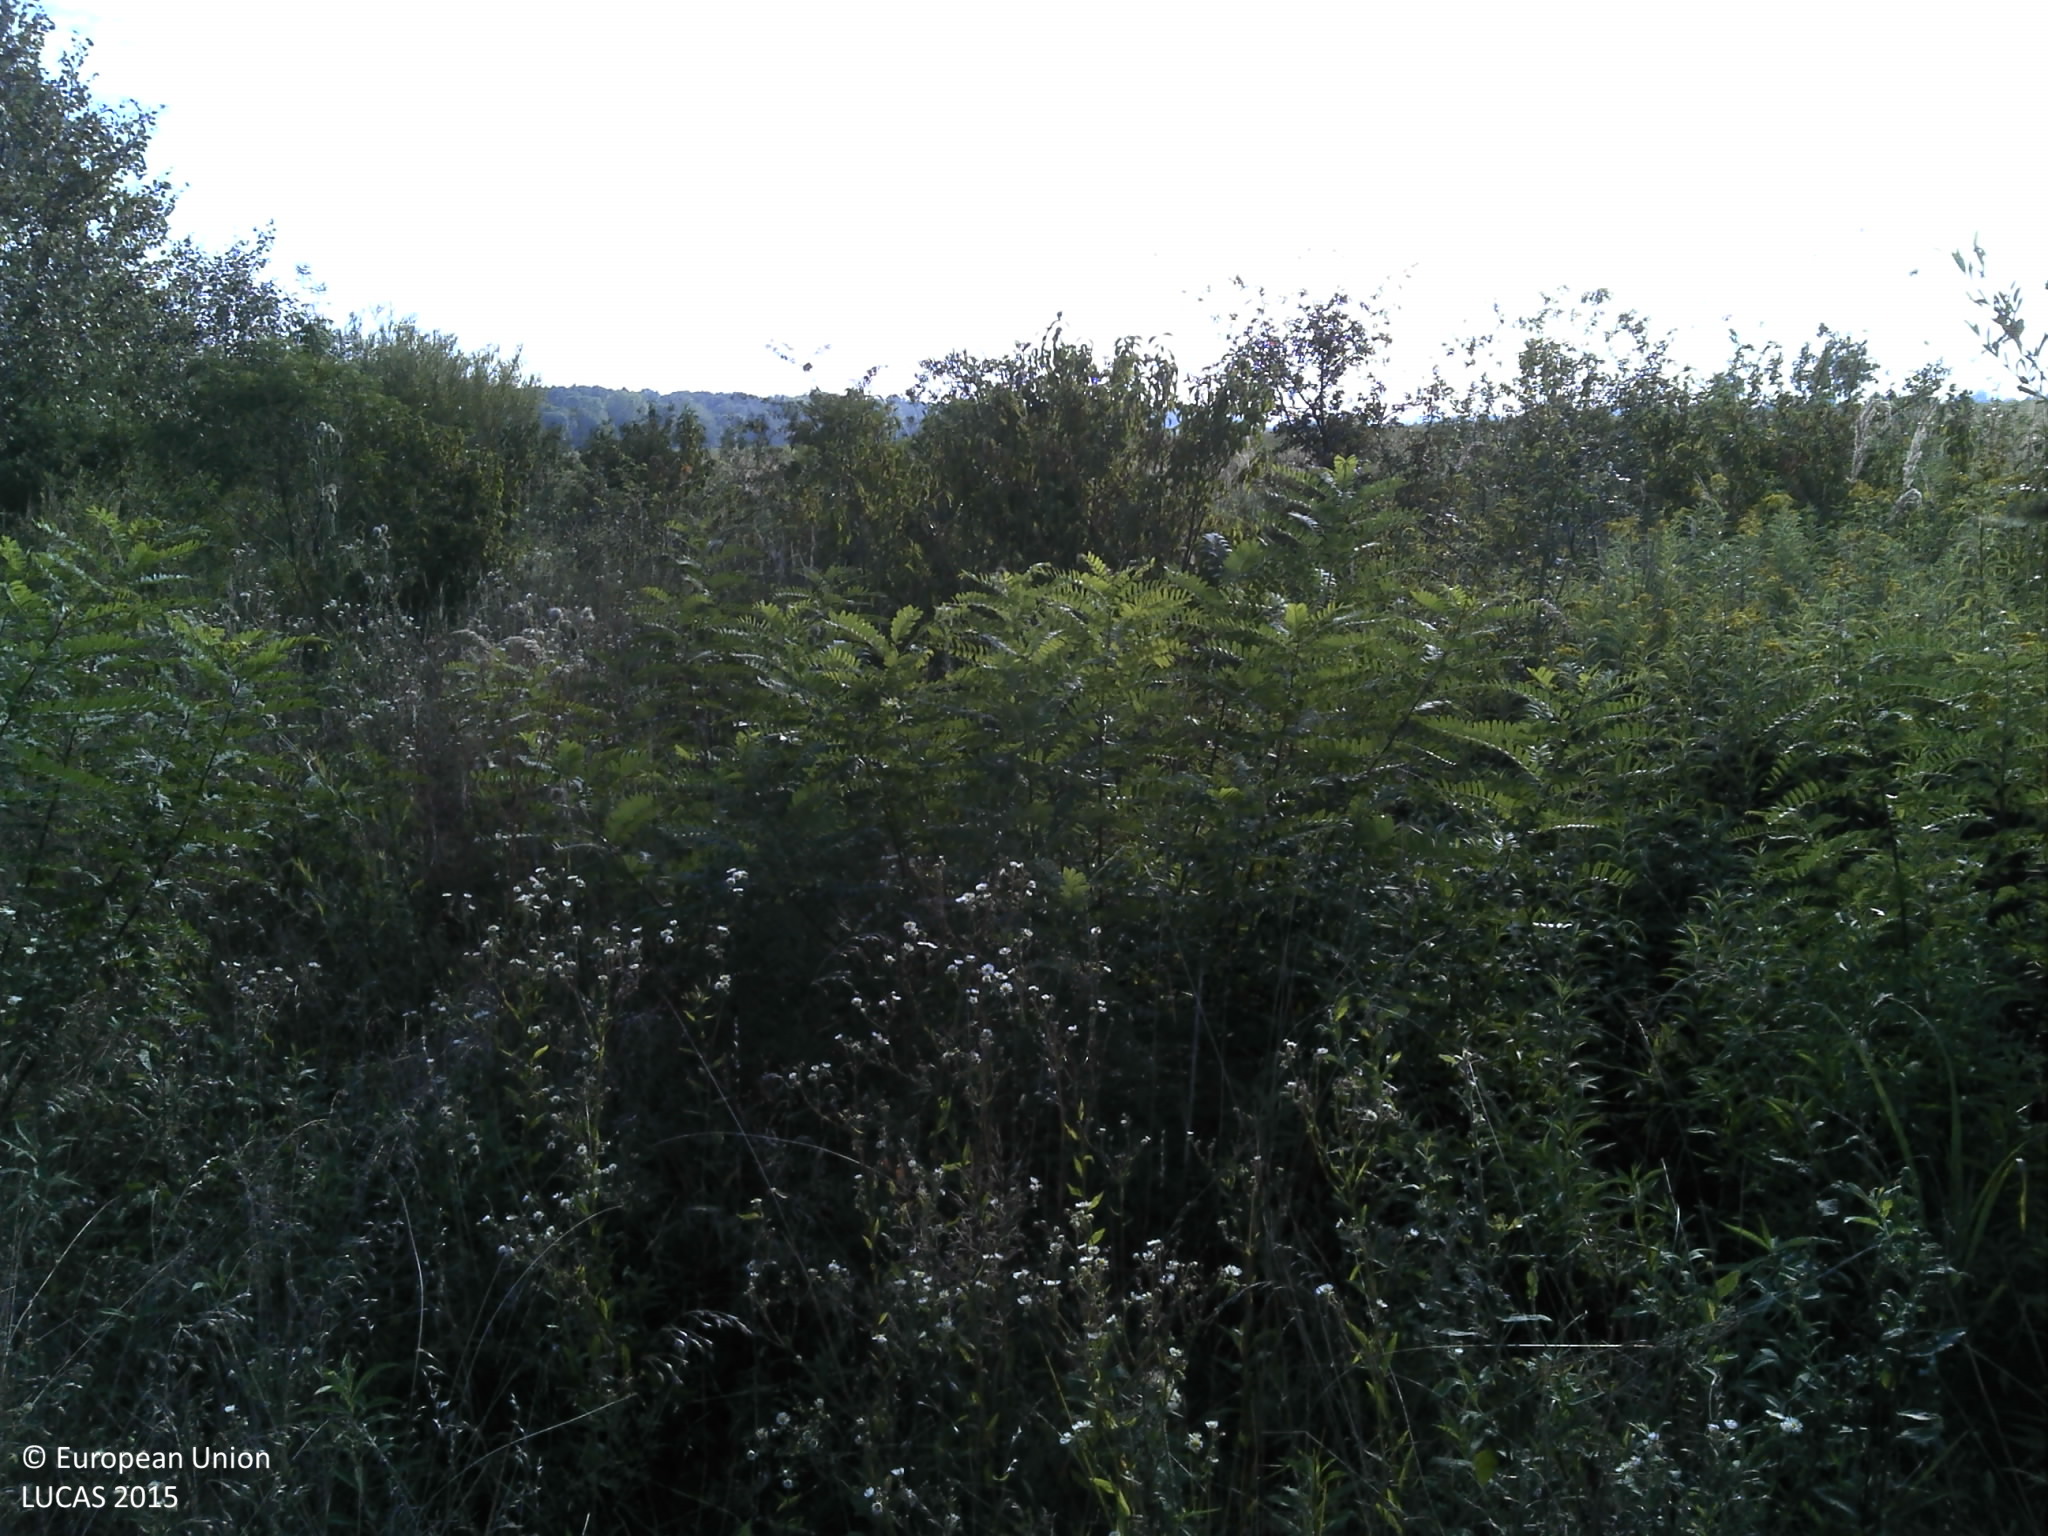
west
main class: Grassland
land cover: Grassland without tree/shrub cover
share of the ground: > 75 %
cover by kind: herbaceous plants 100 %
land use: Semi-natural and natural areas not in use
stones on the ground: < 10 %
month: August
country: HR
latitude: 45.4678
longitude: 16.4827
